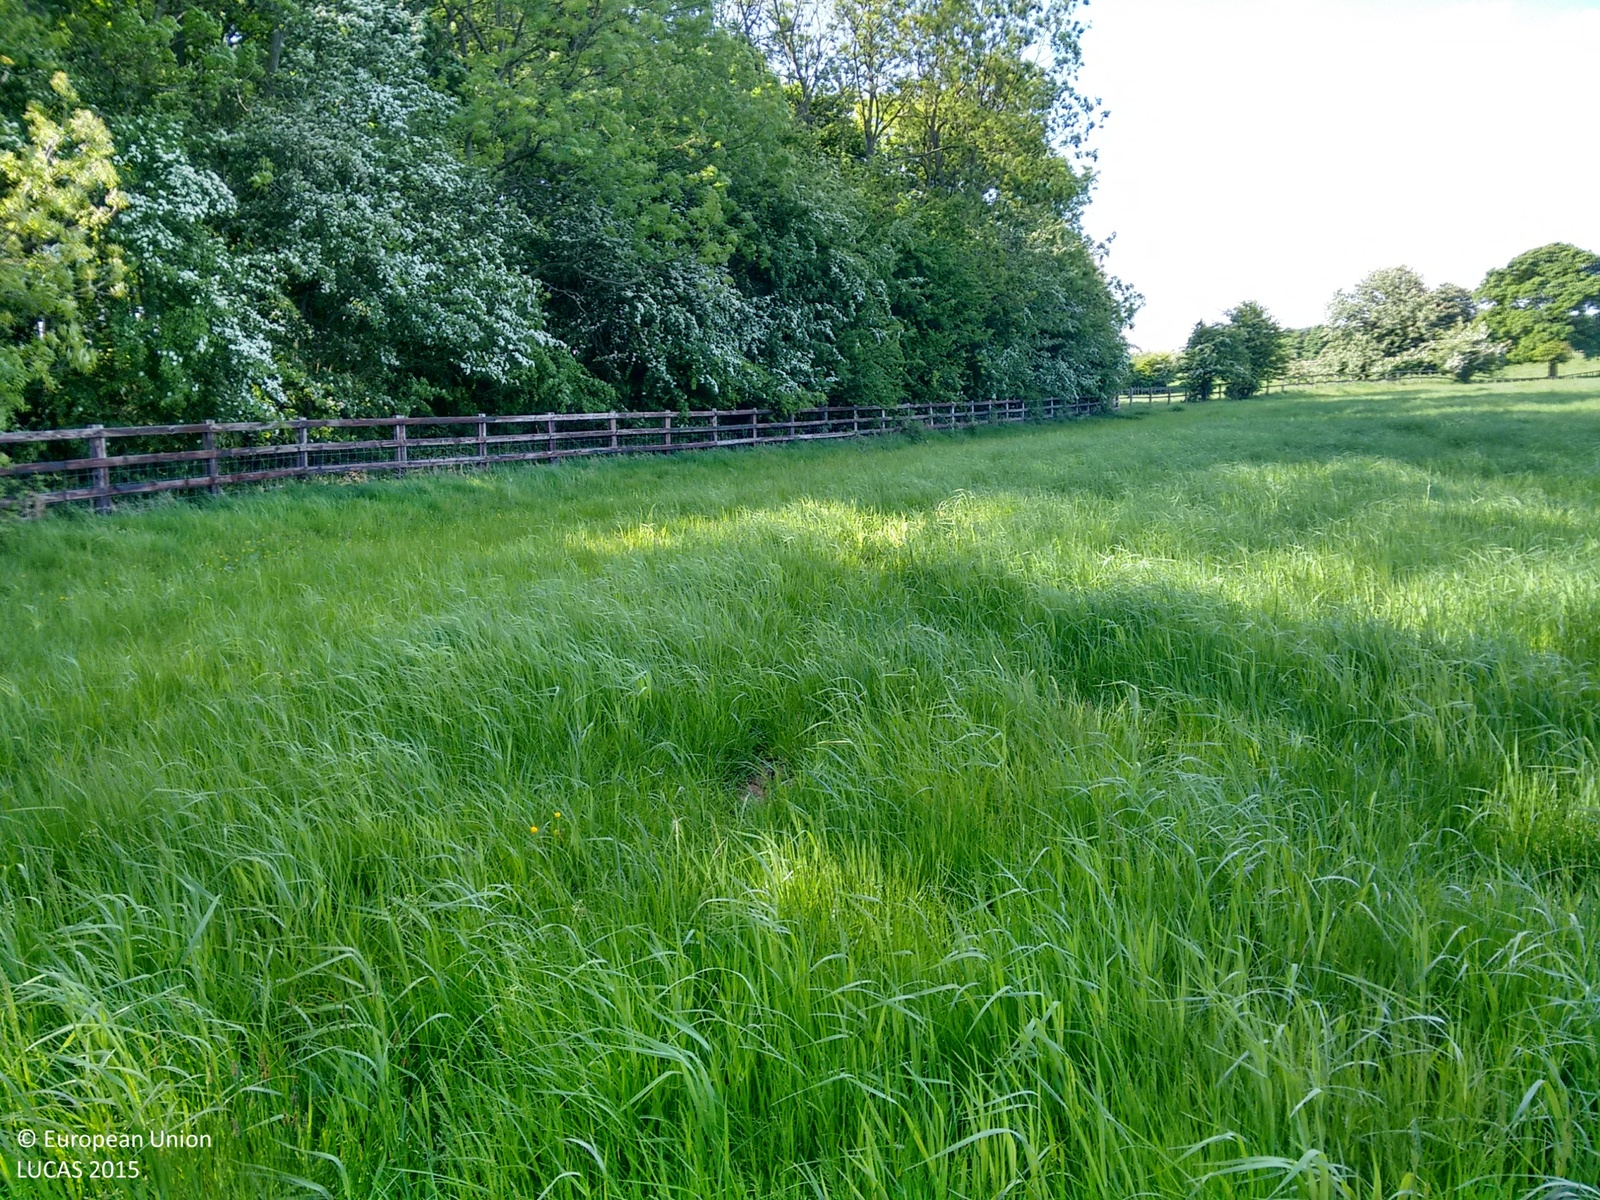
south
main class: Grassland
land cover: Grassland without tree/shrub cover
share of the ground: > 75 %
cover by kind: herbaceous plants 100 %
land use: Agriculture (excluding fallow land and kitchen gardens)
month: May
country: GB
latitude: 53.5966
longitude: -0.2943
